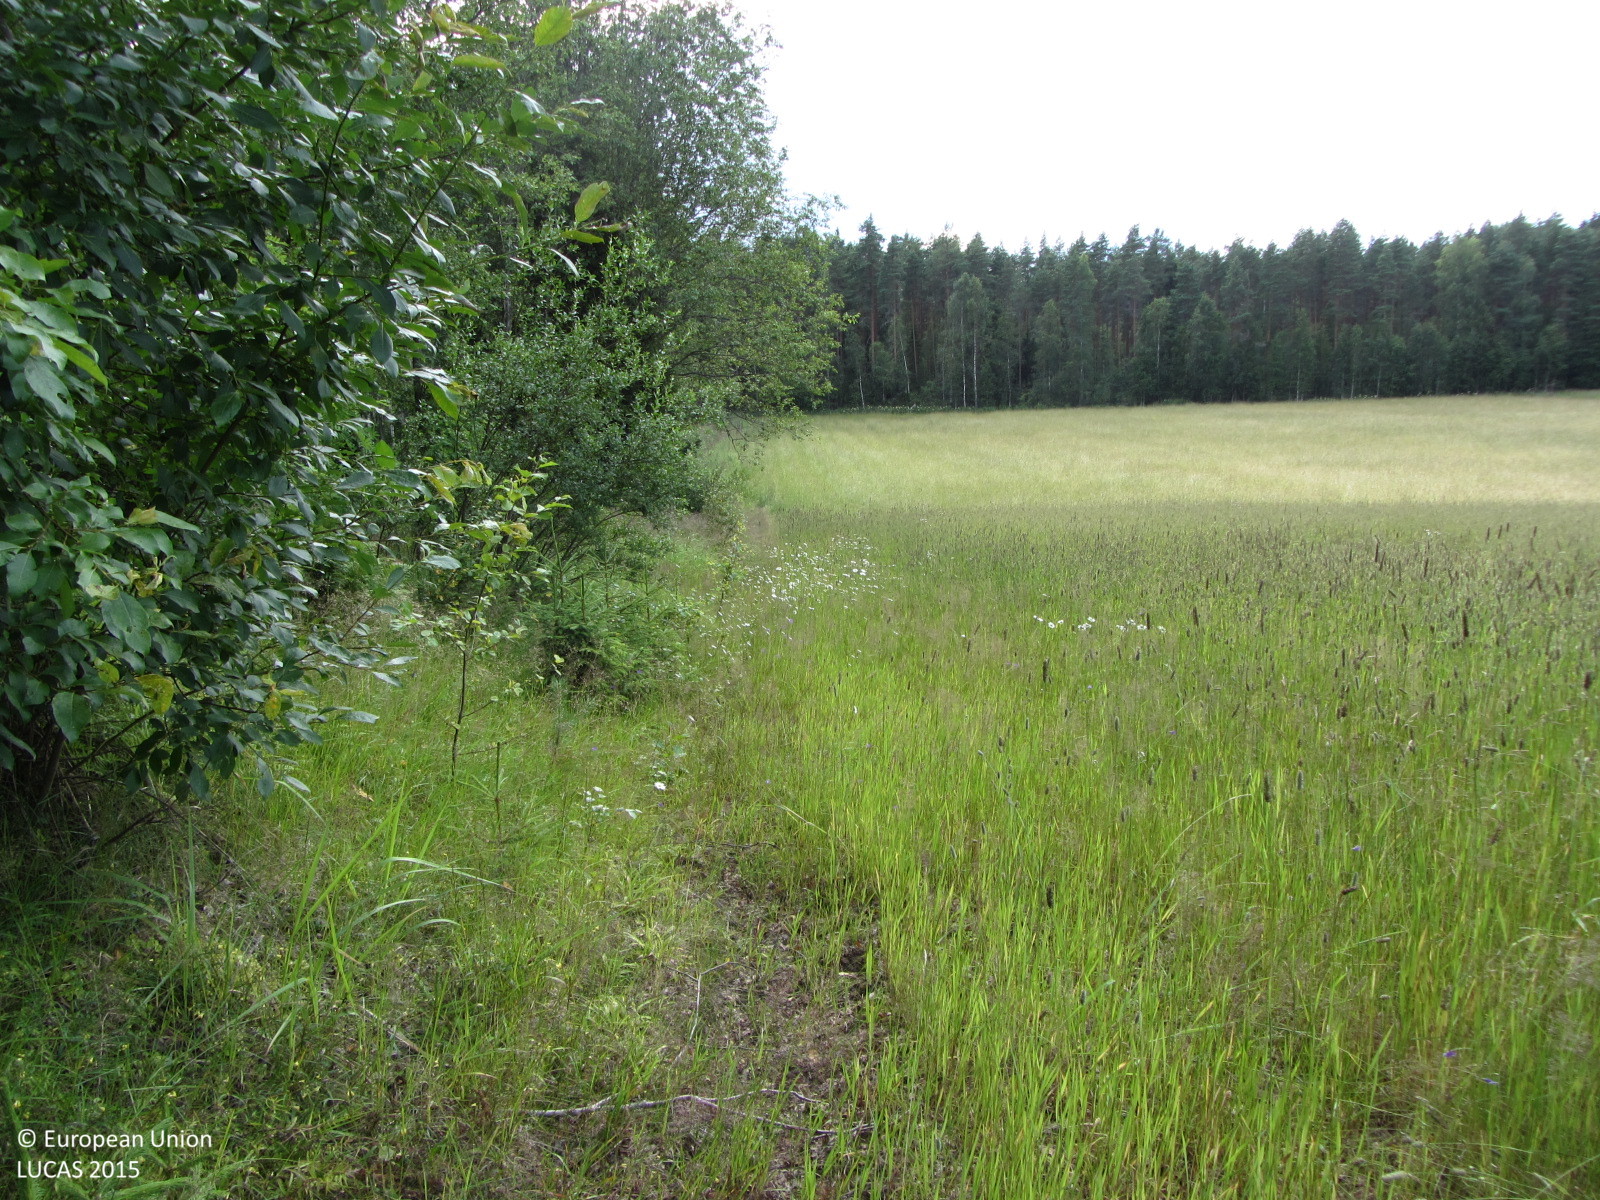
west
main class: Grassland
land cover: Grassland without tree/shrub cover
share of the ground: > 75 %
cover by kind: herbaceous plants 100 %
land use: Agriculture (excluding fallow land and kitchen gardens)
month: July
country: FI
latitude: 60.6451
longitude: 24.4225
